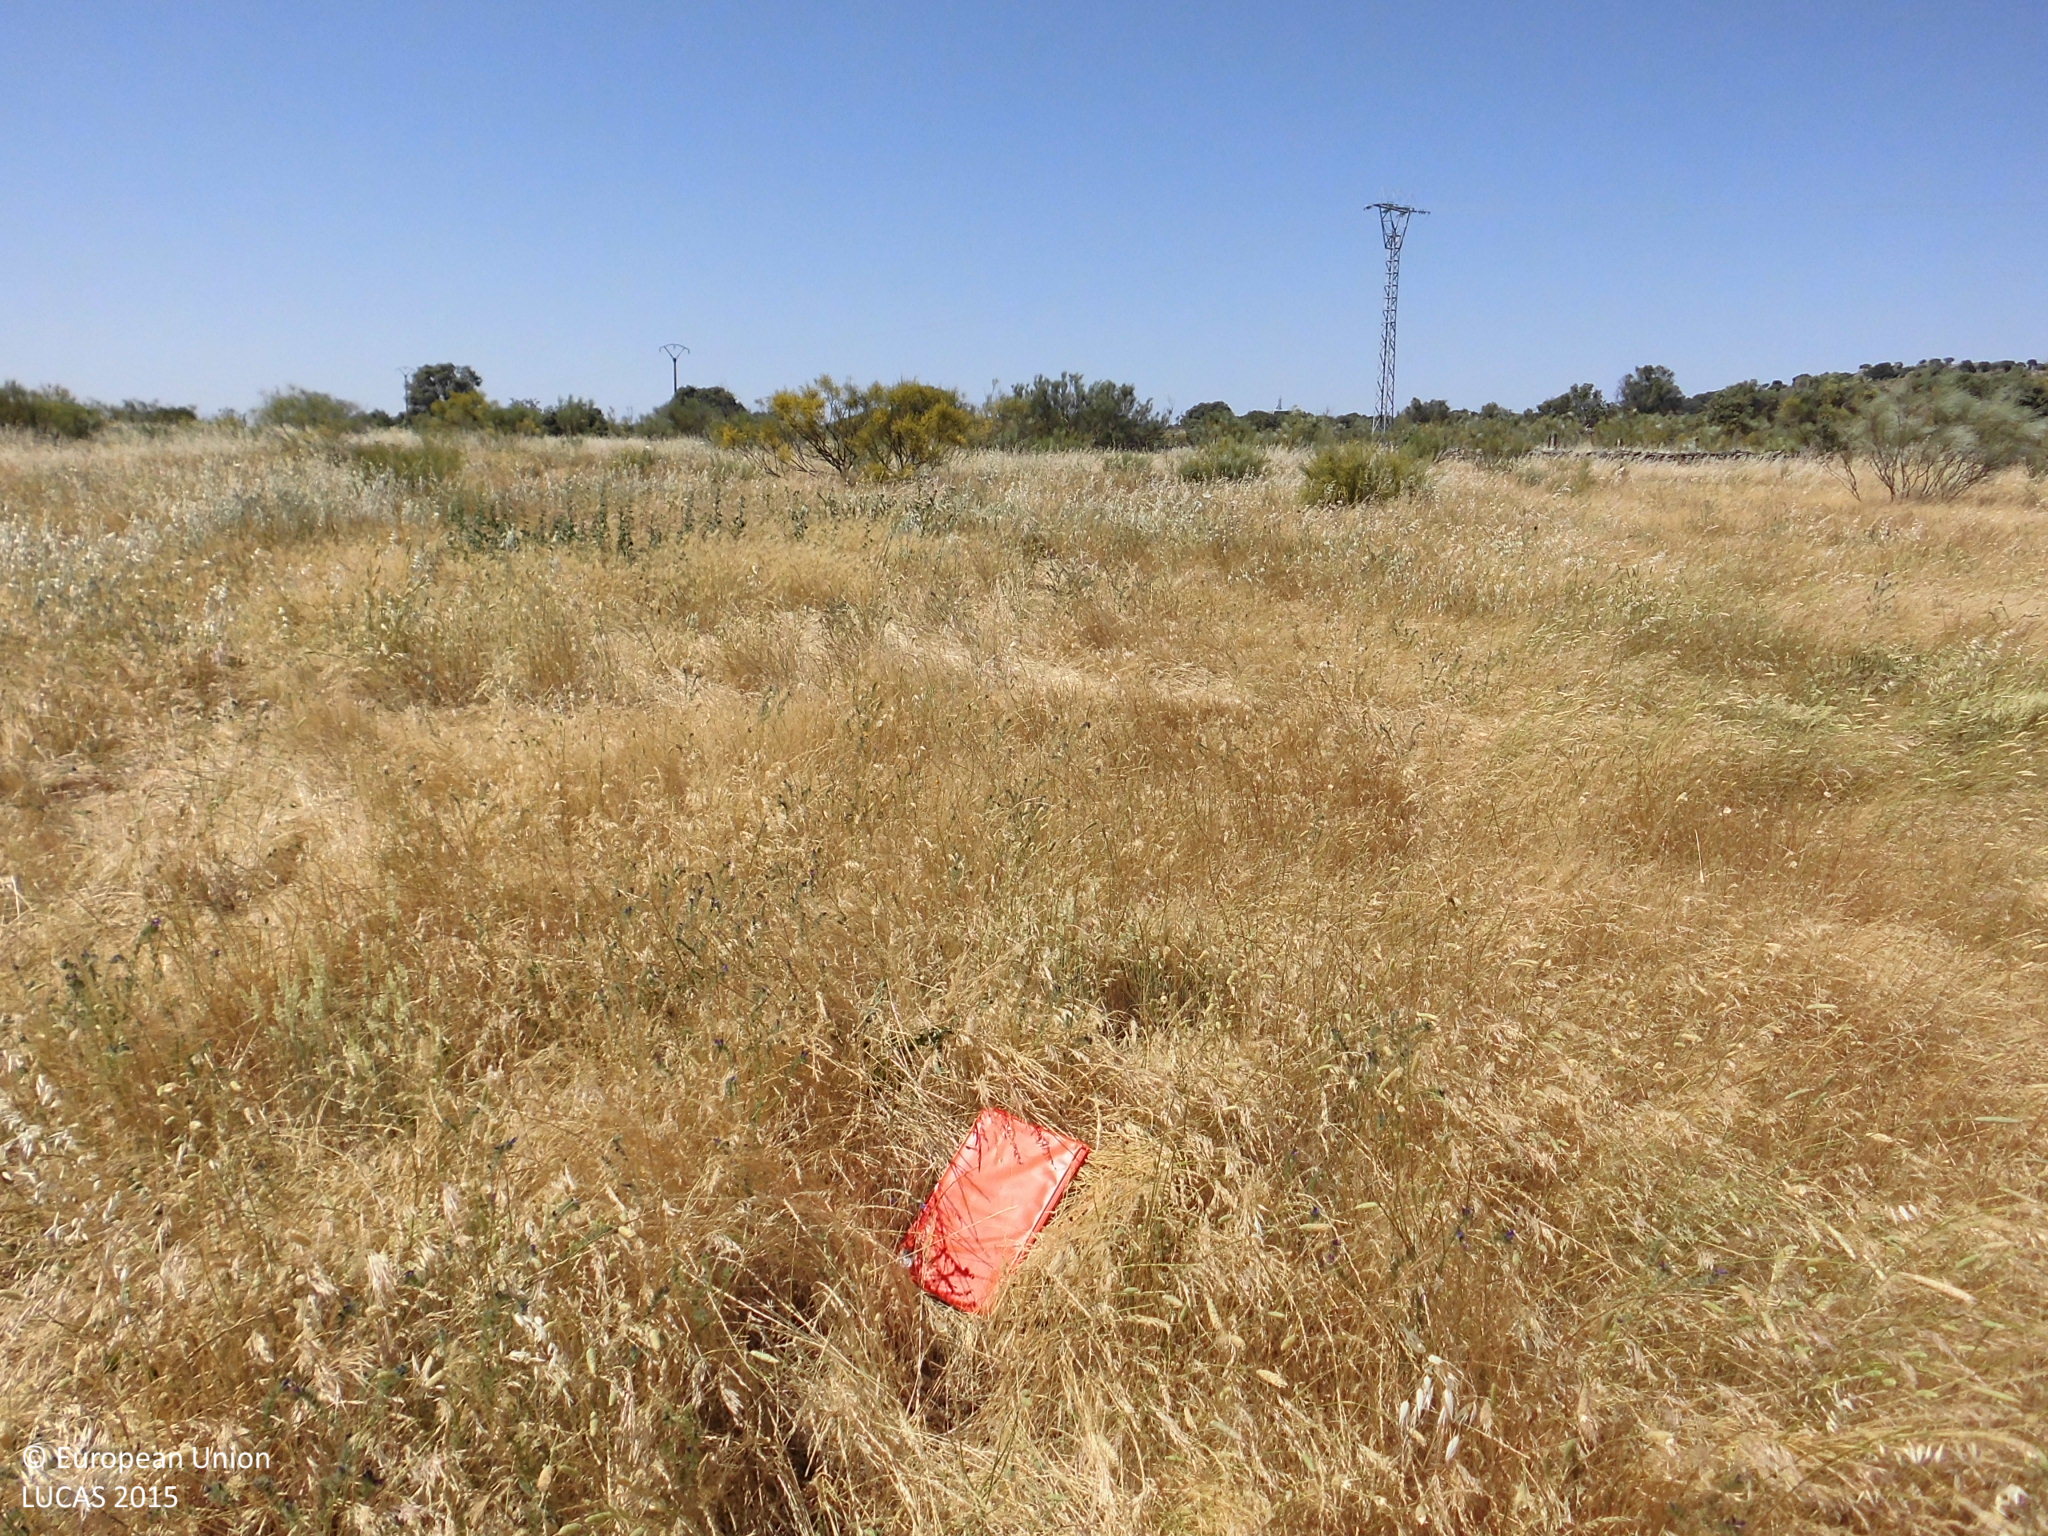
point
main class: Grassland
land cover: Grassland with sparse tree/shrub cover
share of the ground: > 75 %
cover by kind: herbaceous plants 90 %, broadleaved forest trees 5 %, shrubs 5 %
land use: Agriculture (excluding fallow land and kitchen gardens)
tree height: > 5 m
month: May
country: ES
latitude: 39.3396
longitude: -6.0591
